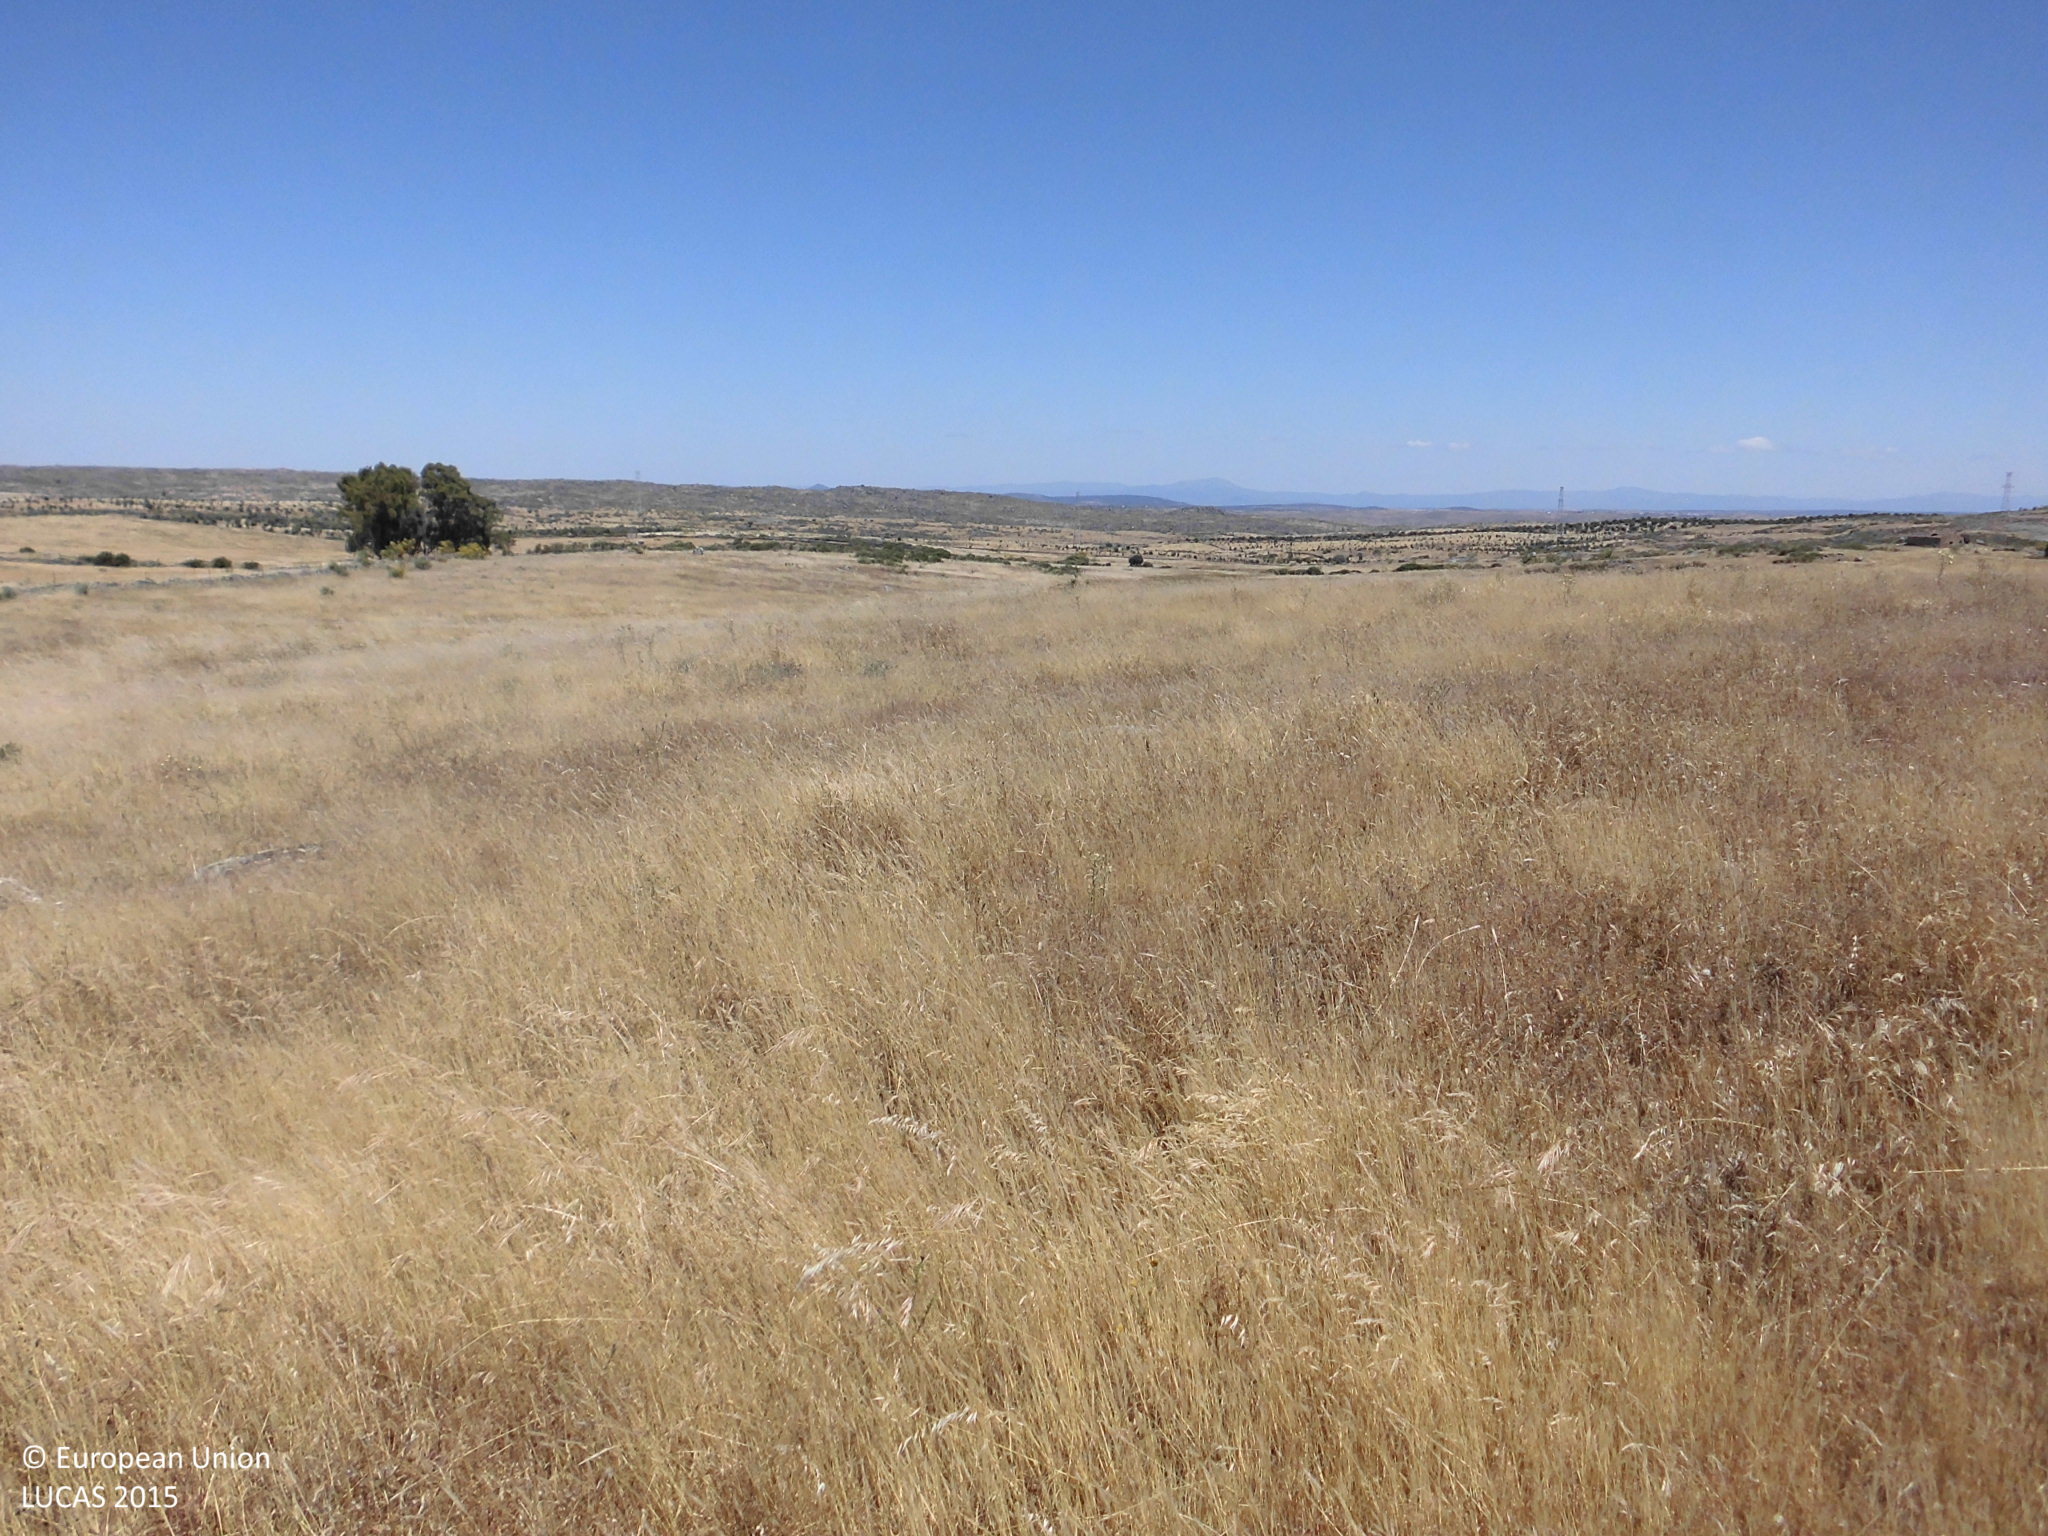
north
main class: Grassland
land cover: Grassland without tree/shrub cover
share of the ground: > 75 %
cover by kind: herbaceous plants 100 %
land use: Agriculture (excluding fallow land and kitchen gardens)
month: May
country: ES
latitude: 39.6994
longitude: -6.6497
